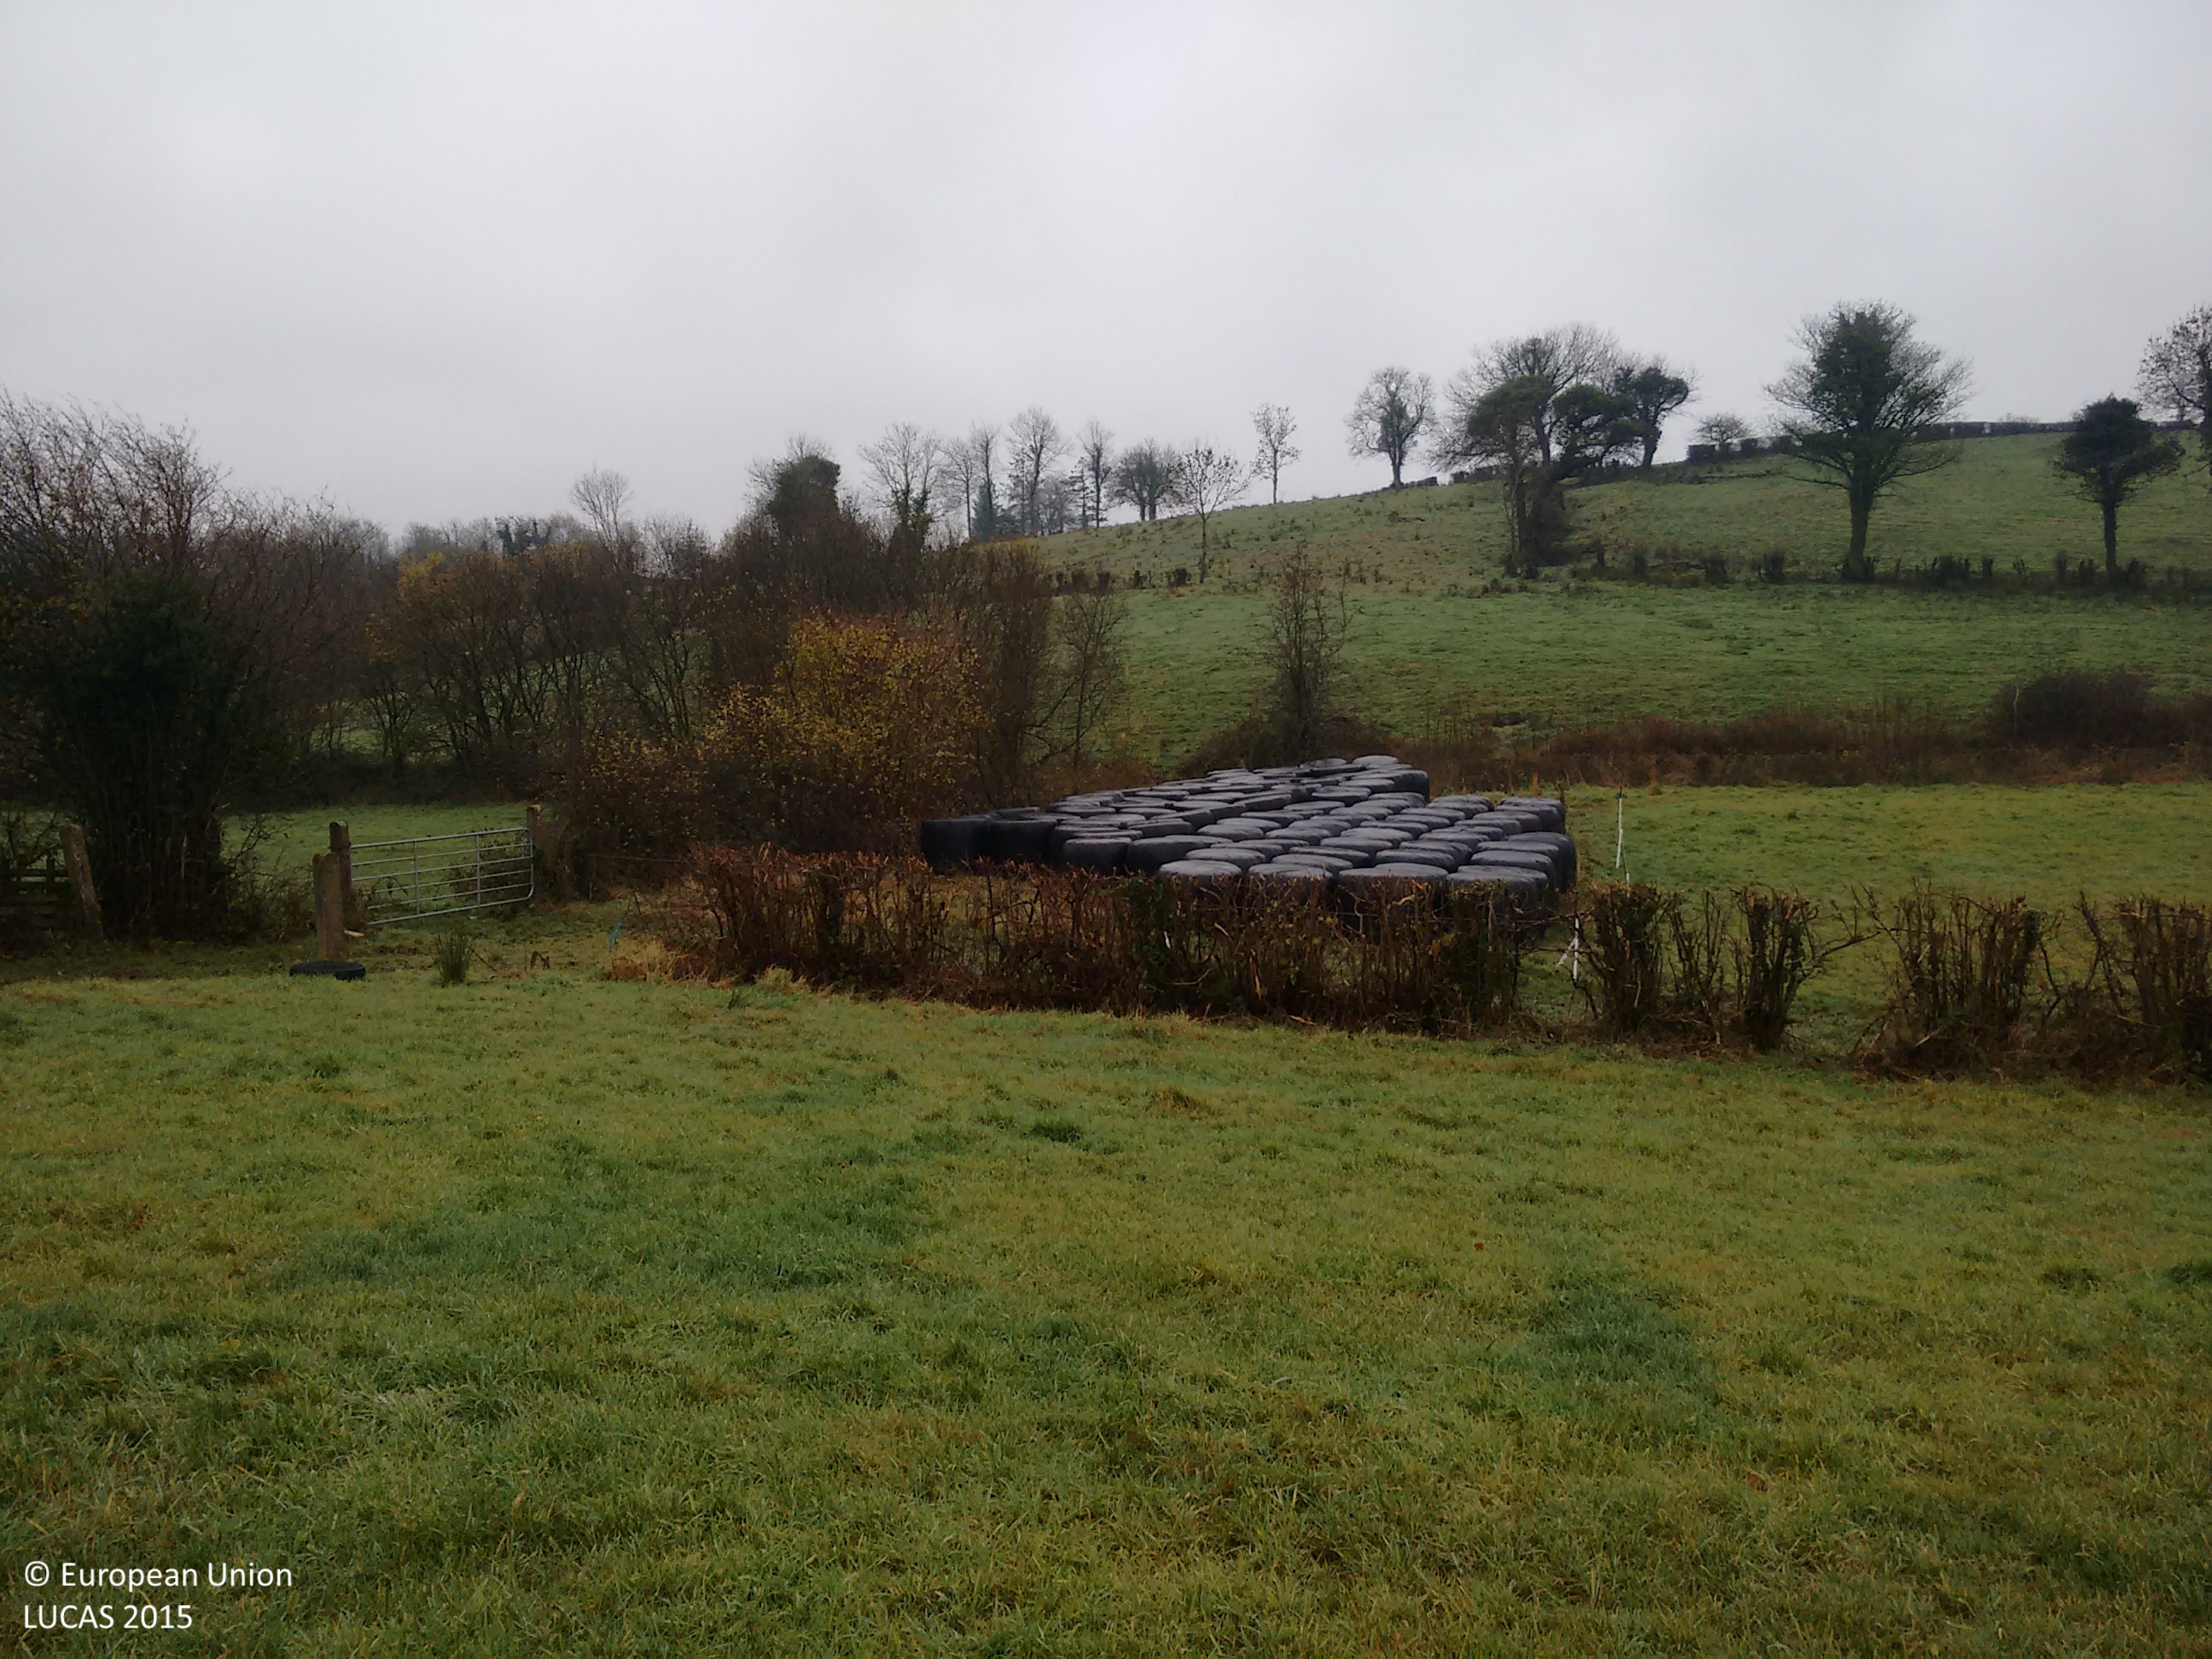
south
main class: Grassland
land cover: Grassland without tree/shrub cover
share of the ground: > 75 %
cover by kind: herbaceous plants 100 %
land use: Agriculture (excluding fallow land and kitchen gardens)
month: December
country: GB
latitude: 54.2094
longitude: -7.2758
